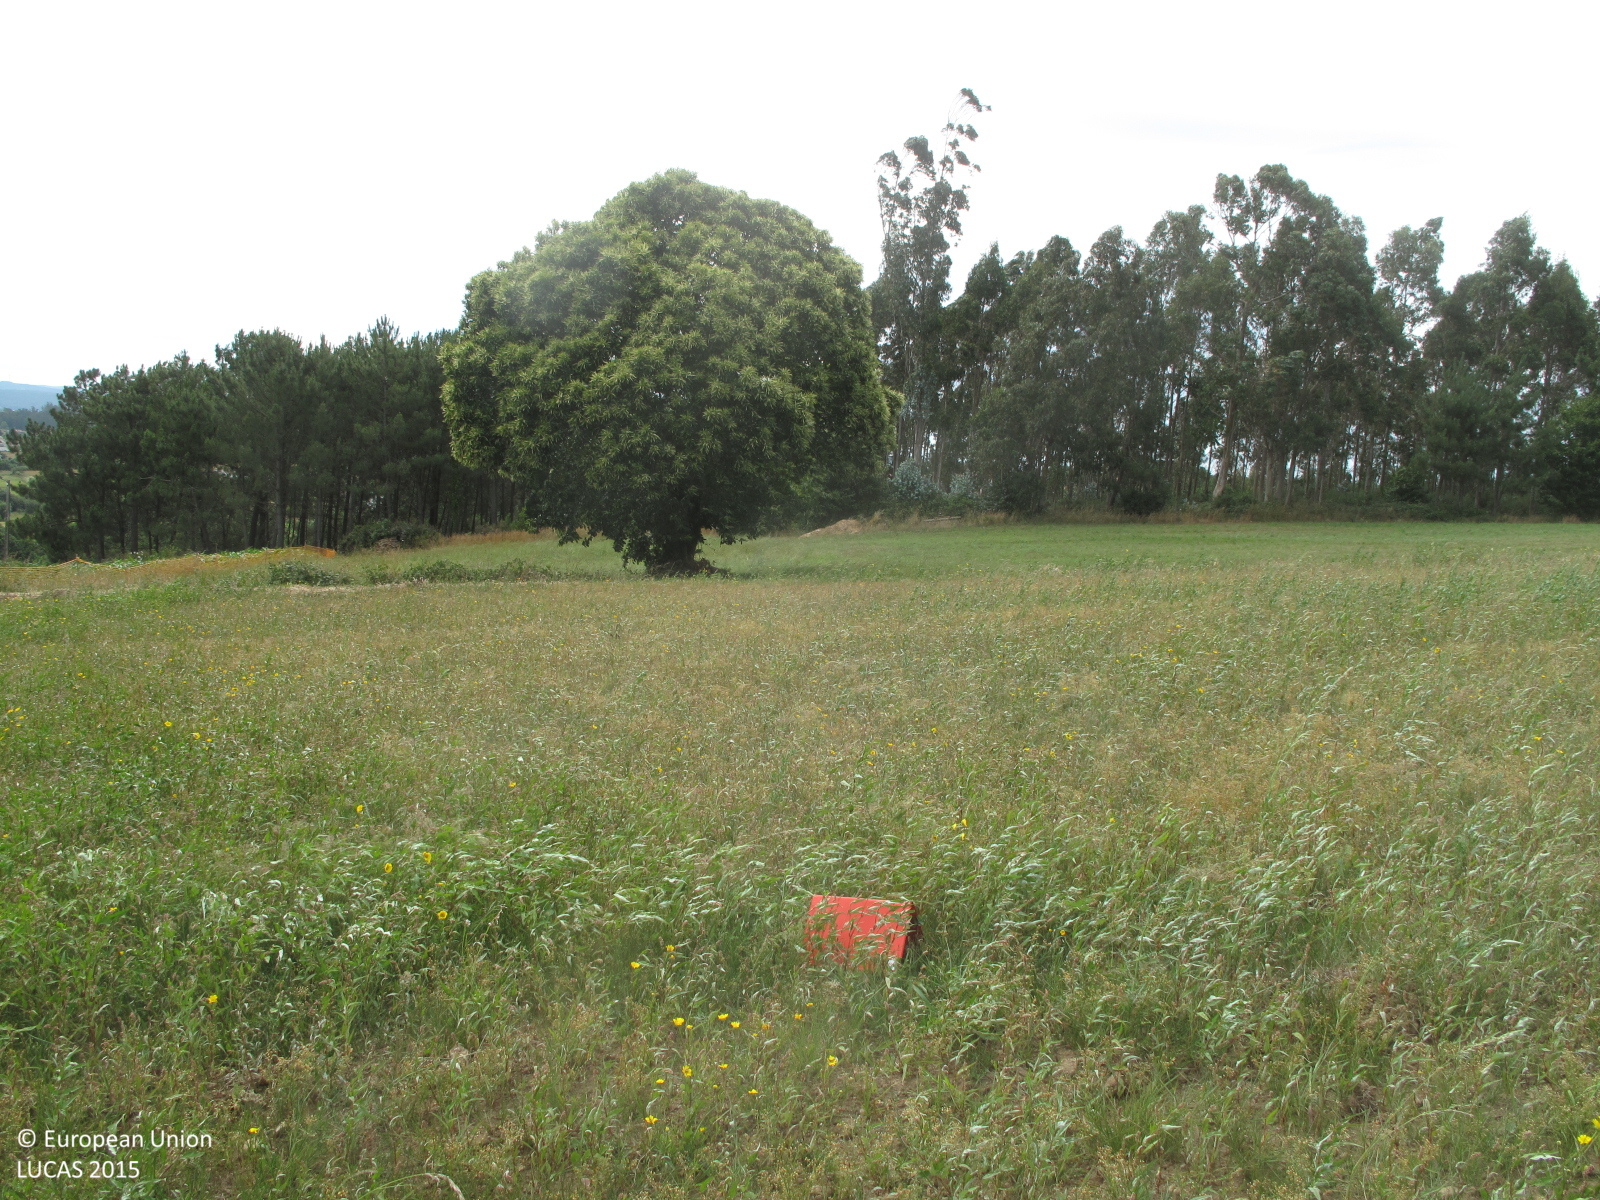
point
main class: Grassland
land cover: Spontaneously vegetated surfaces
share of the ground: 50 - 75 %
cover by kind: herbaceous plants 70 %, unconsolidated bare surface 30 %
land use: Fallow land
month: July
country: ES
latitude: 43.2160
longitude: -8.6387
